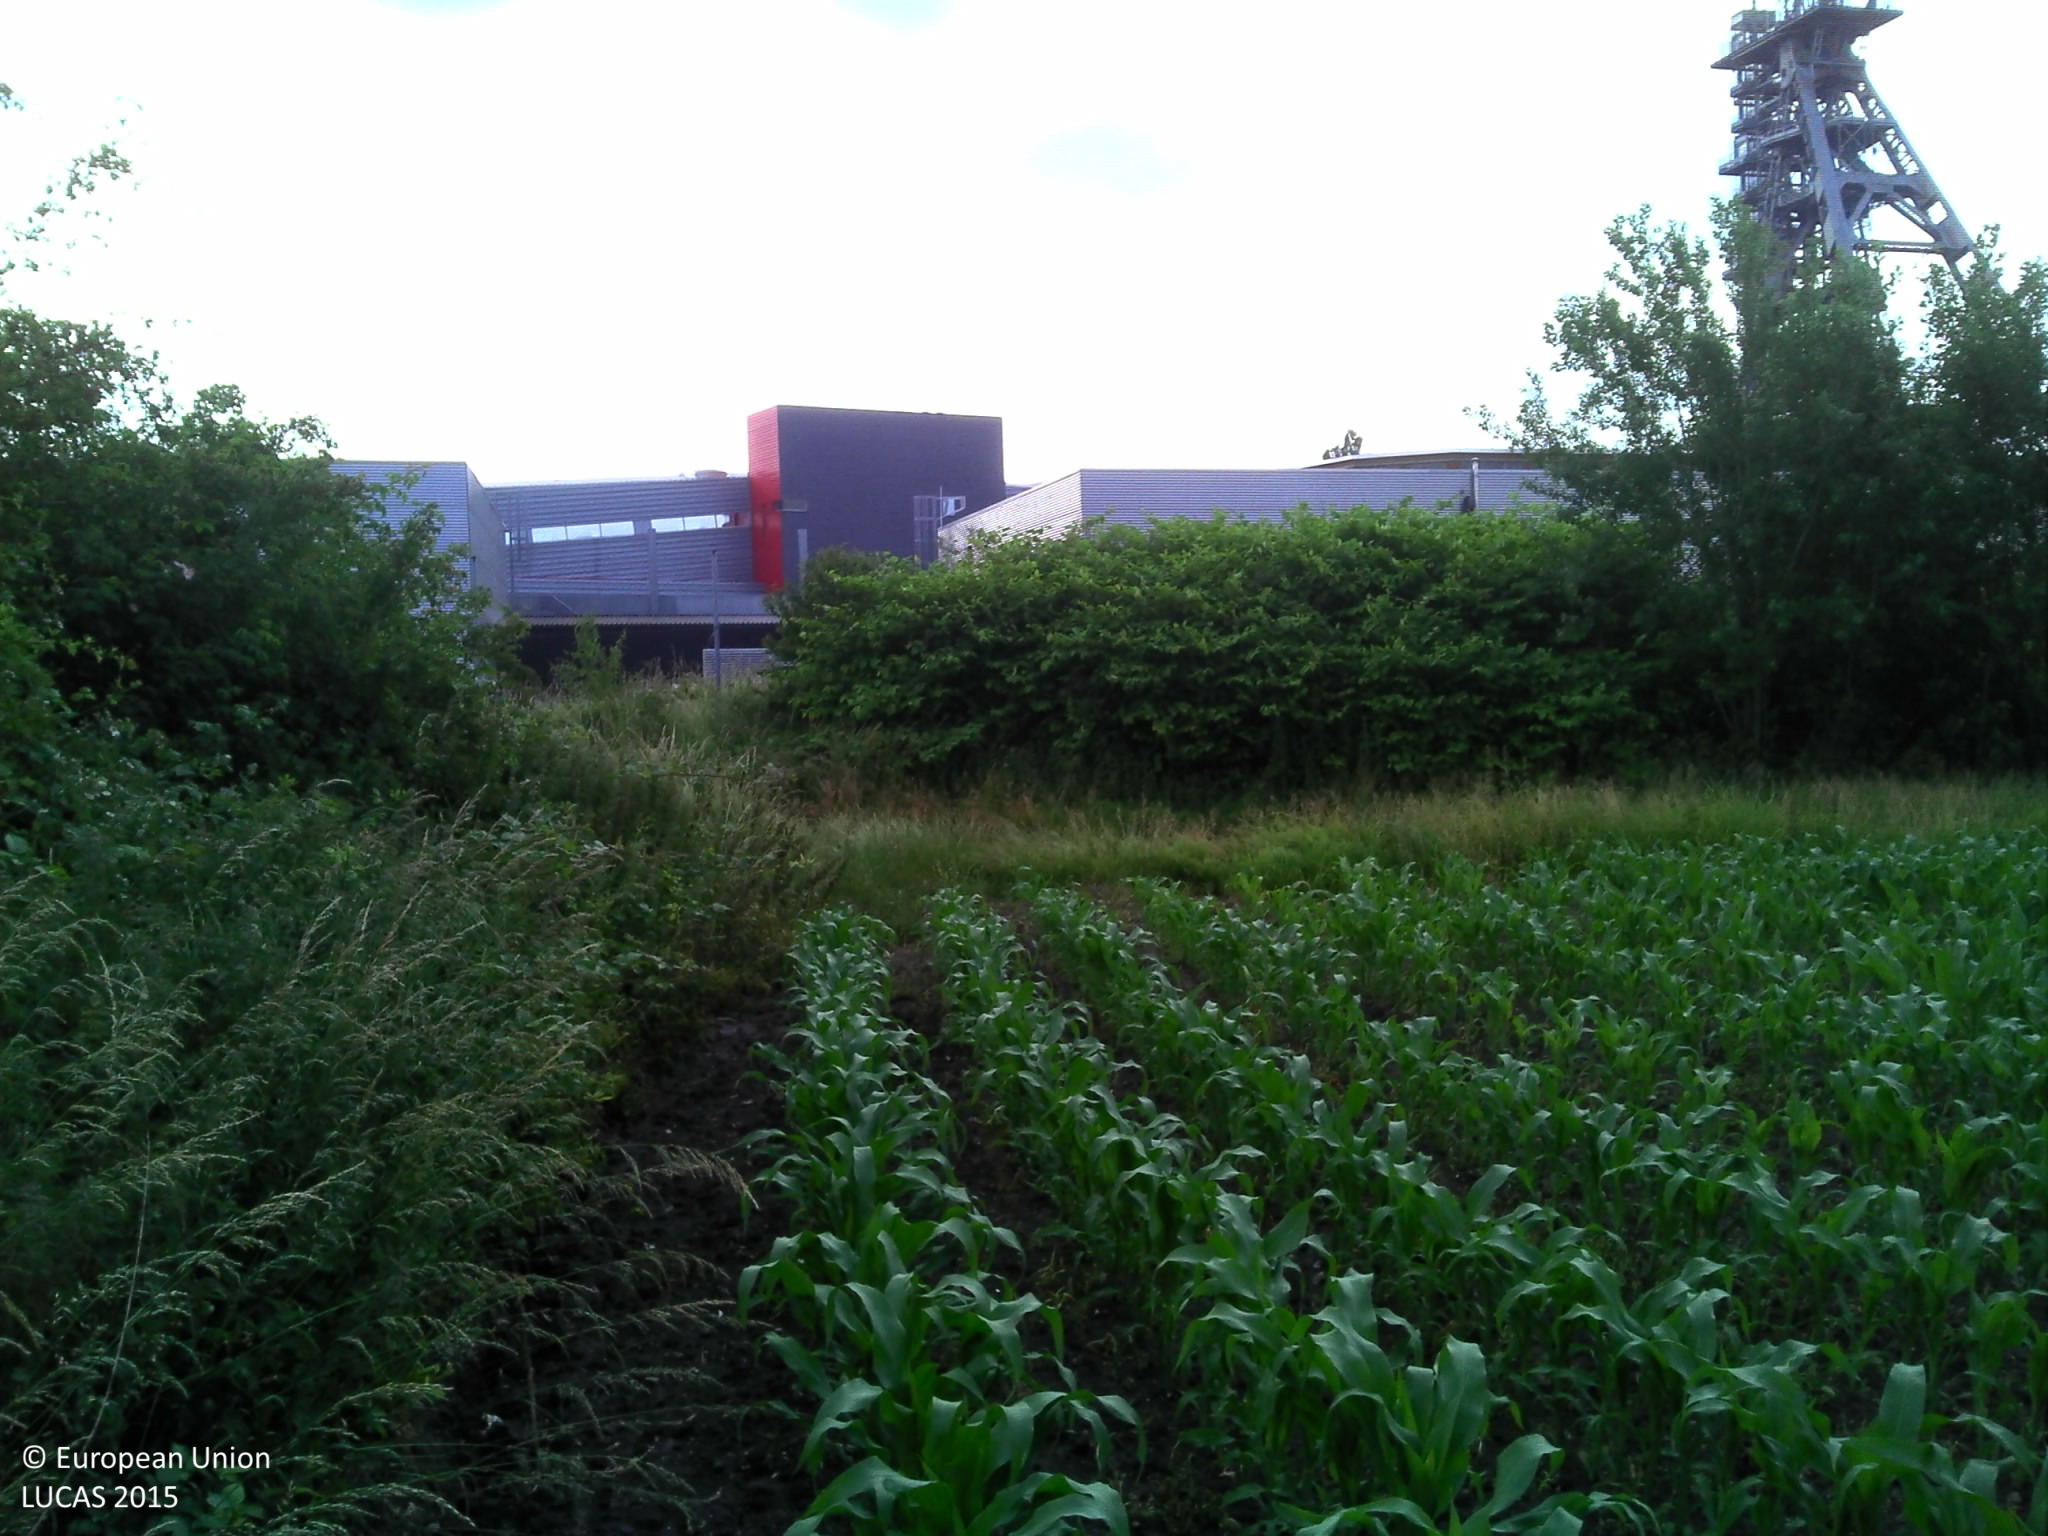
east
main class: Cropland
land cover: Maize
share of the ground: 25 - 50 %
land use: Agriculture (excluding fallow land and kitchen gardens)
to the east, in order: Maize; Grass margins; Managed hedges; Spontaneously vegetated surfaces; Fences; Spontaneously vegetated surfaces; Artificial constructions in urban areas; Broadleaved woodland; Artificial constructions in urban areas; Broadleaved woodland
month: June
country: BE
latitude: 50.4177
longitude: 3.8999
